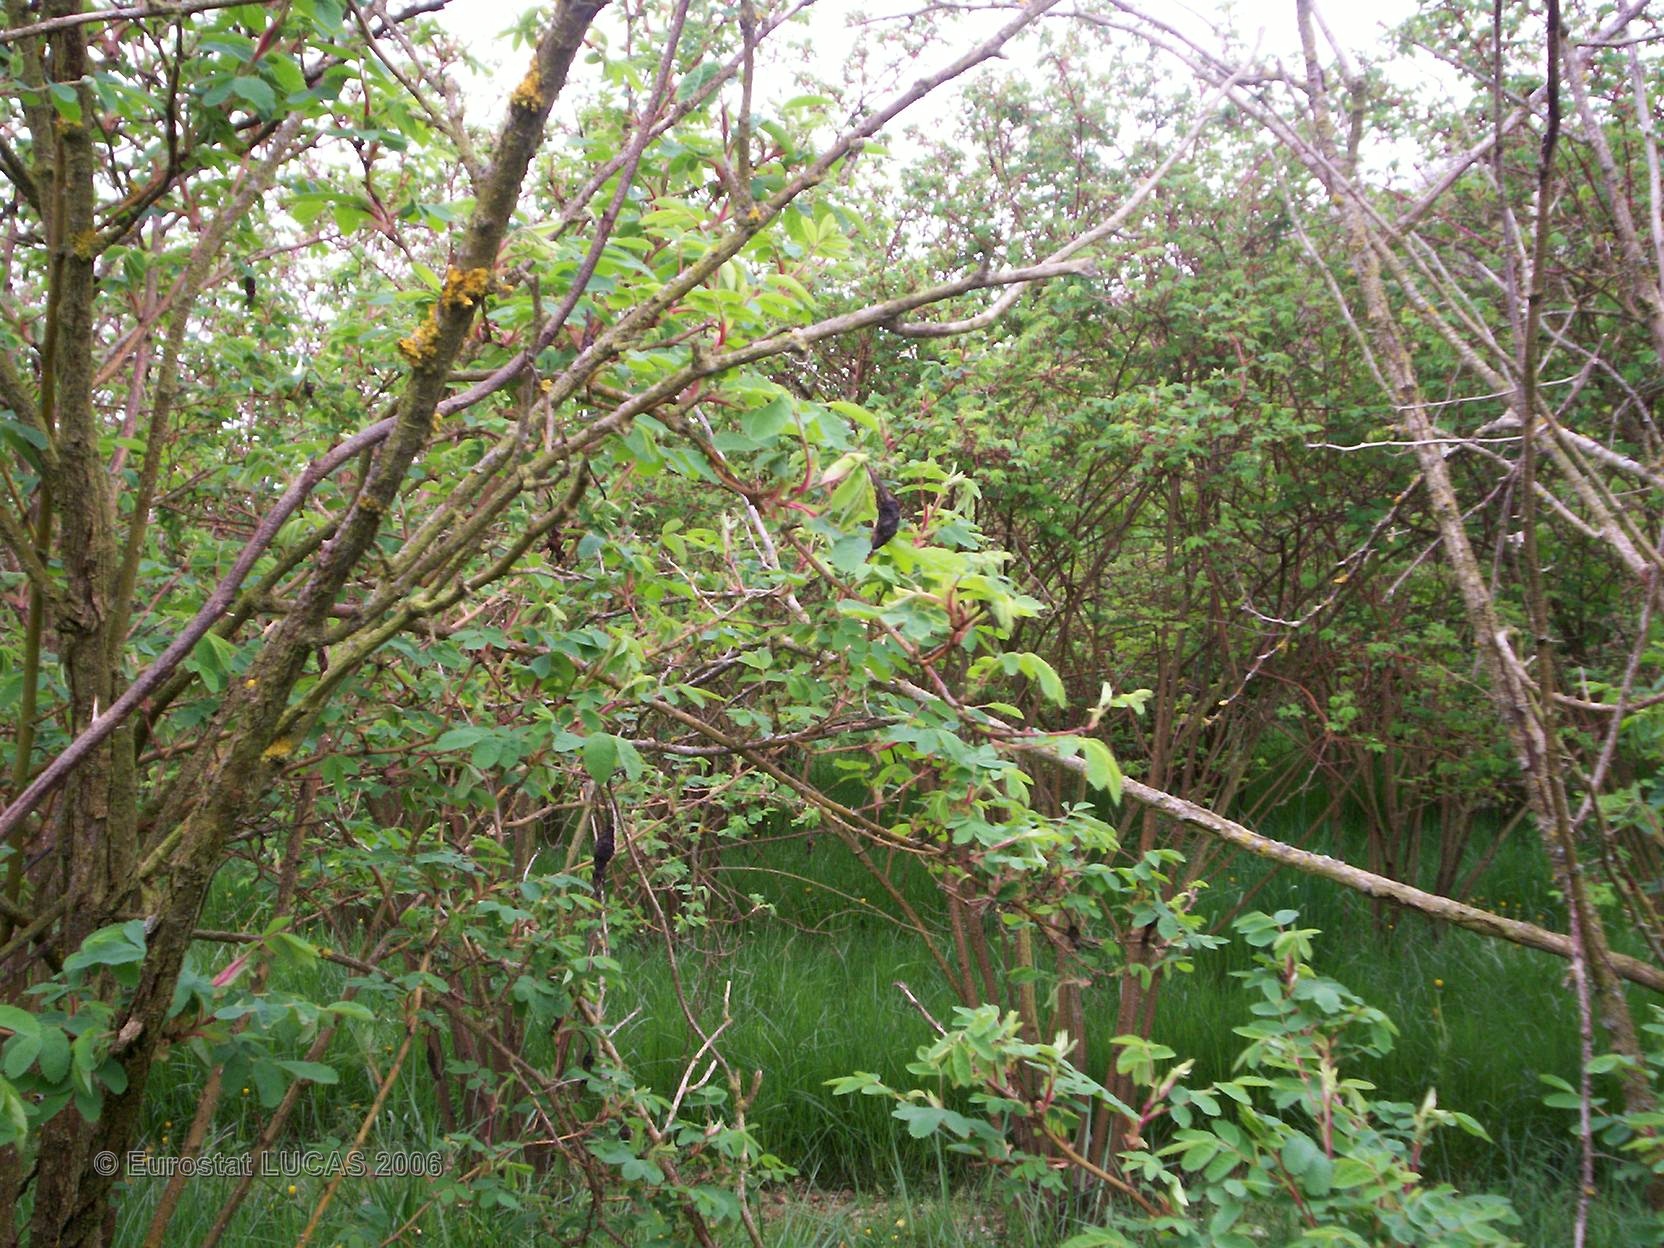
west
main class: Cropland
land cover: Other fruit trees and berries
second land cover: Grassland with sparse tree/shrub cover
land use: Agriculture (excluding fallow land and kitchen gardens)
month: April
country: FR
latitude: 48.0467
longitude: 2.8690
